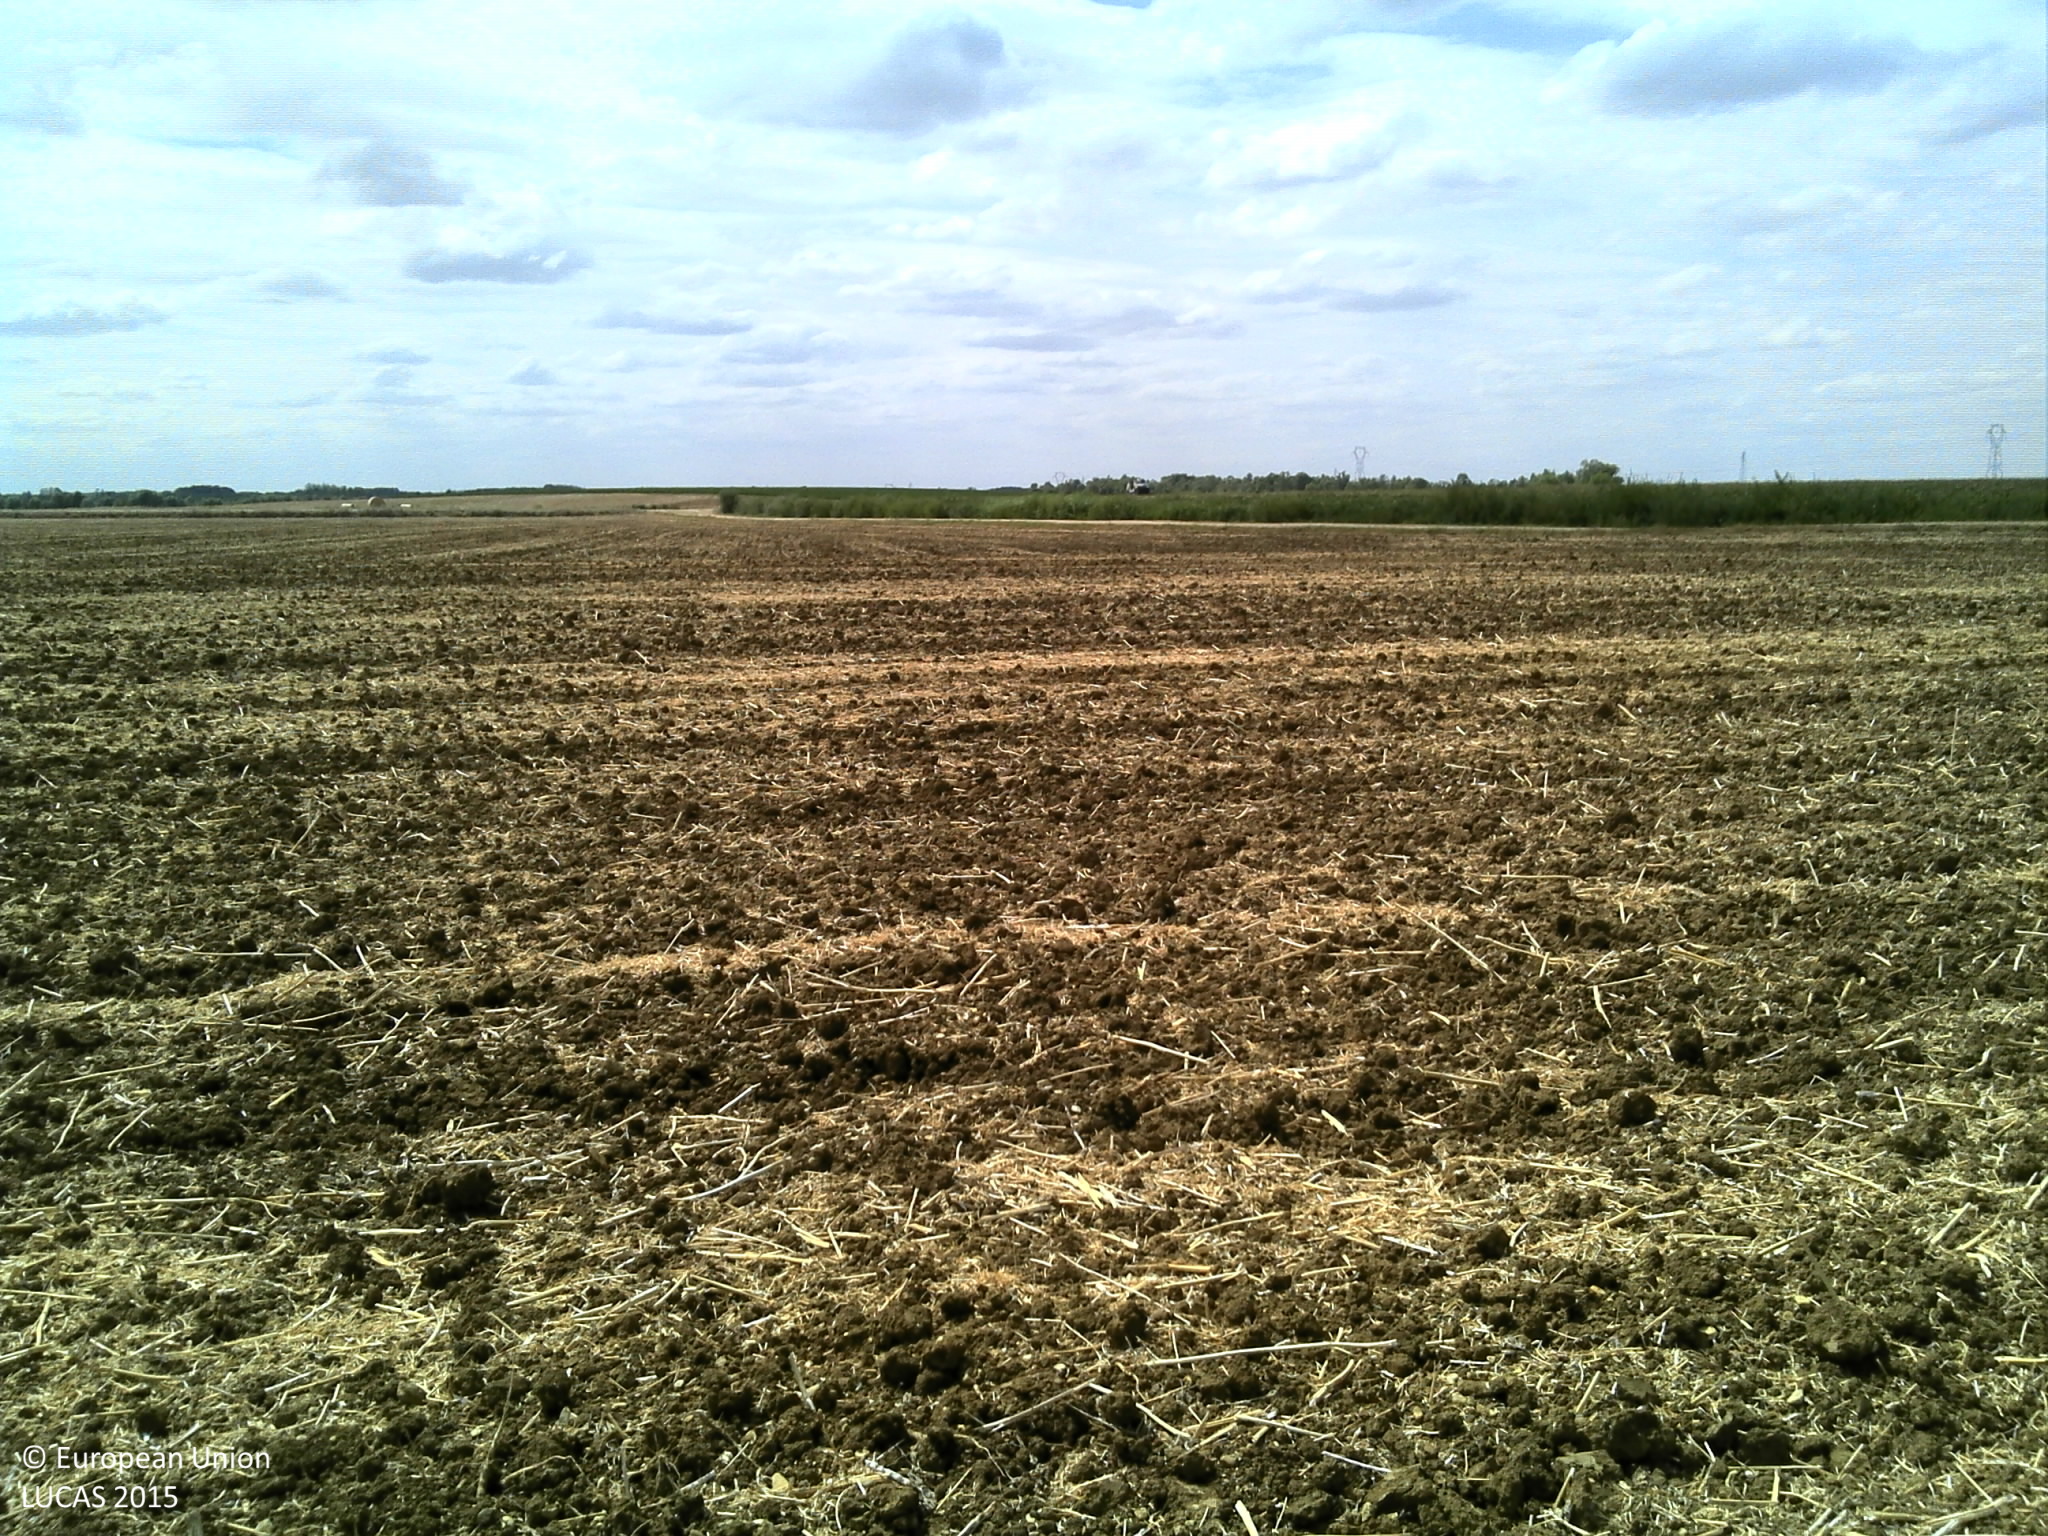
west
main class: Cropland
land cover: Rape and turnip rape
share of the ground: > 75 %
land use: Agriculture (excluding fallow land and kitchen gardens)
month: July
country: FR
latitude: 48.6546
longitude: 4.6897
